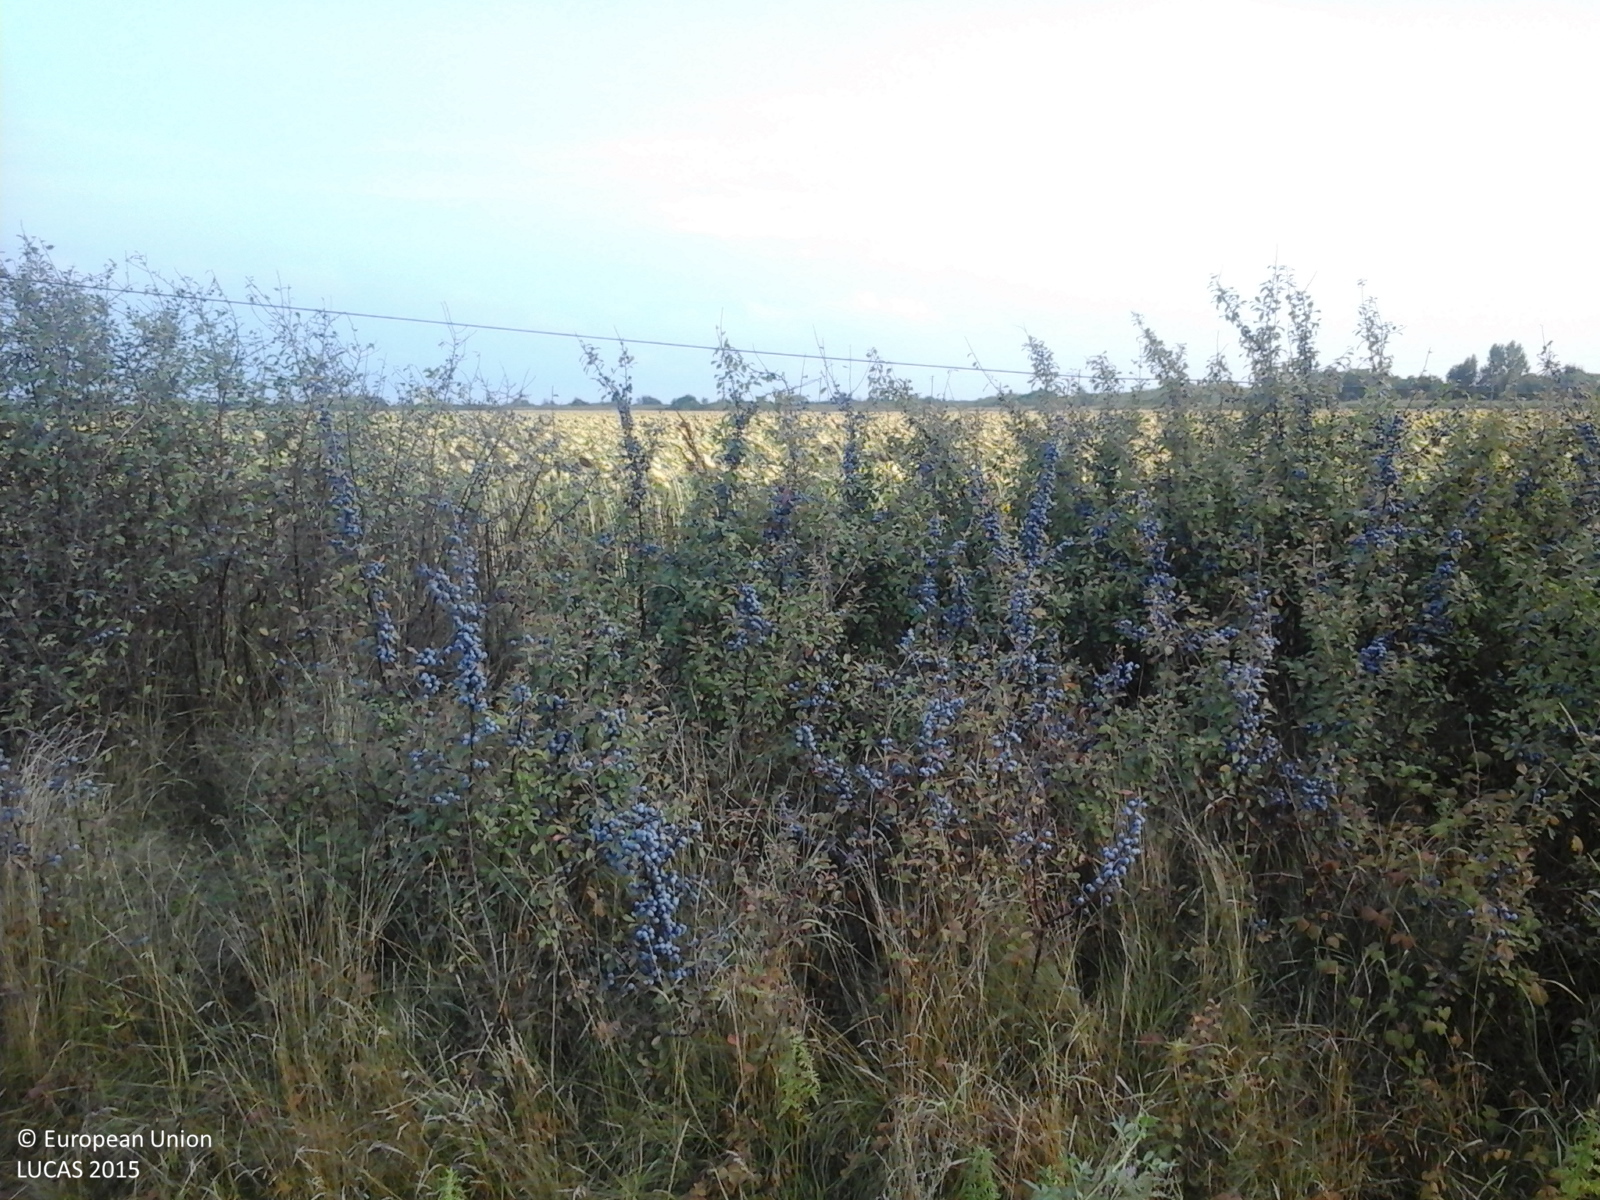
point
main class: Cropland
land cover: Sunflower
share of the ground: > 75 %
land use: Agriculture (excluding fallow land and kitchen gardens)
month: August
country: RO
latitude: 45.9916
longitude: 20.3640
